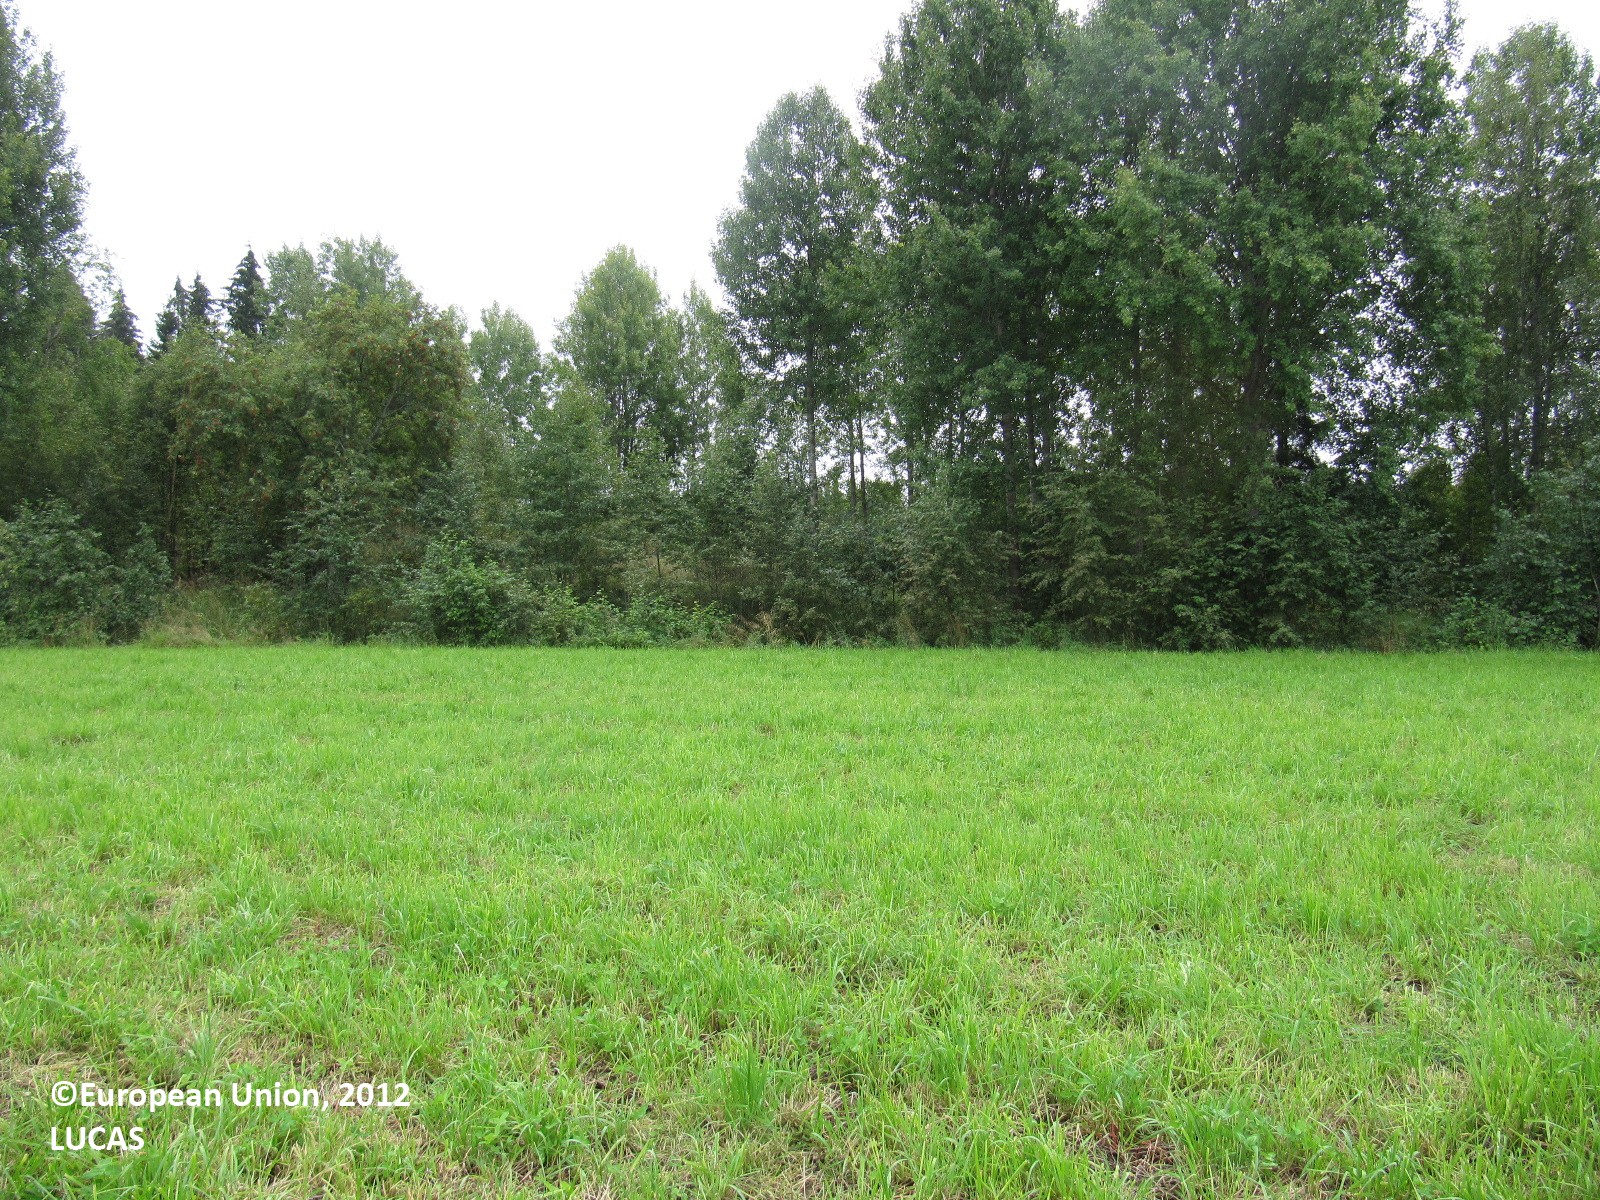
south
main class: Grassland
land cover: Grassland without tree/shrub cover
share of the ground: > 75 %
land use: Agriculture (excluding fallow land and kitchen gardens)
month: August
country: FI
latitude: 61.1030
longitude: 23.4946
